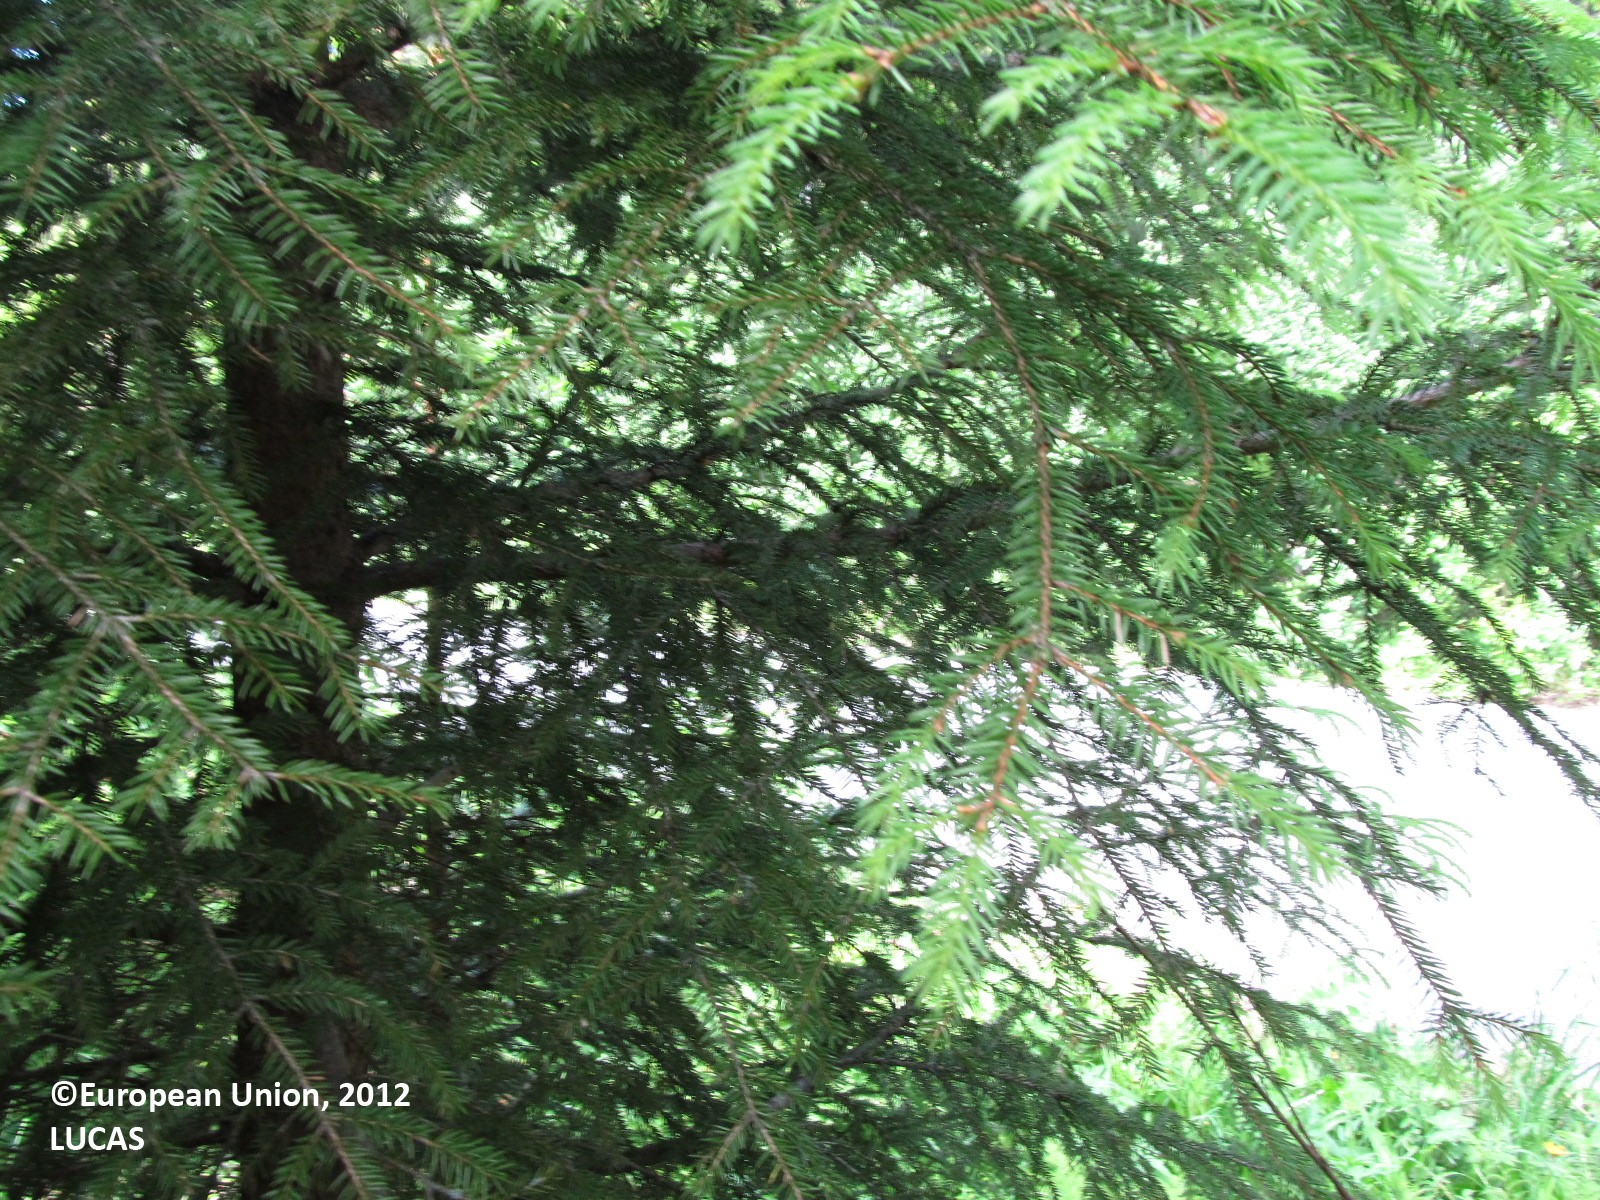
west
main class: Woodland
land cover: Broadleaved woodland
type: boreal forest
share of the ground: 50 - 75 %
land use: Forestry
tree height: > 5 m
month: June
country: FI
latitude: 62.8760
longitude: 27.4834
